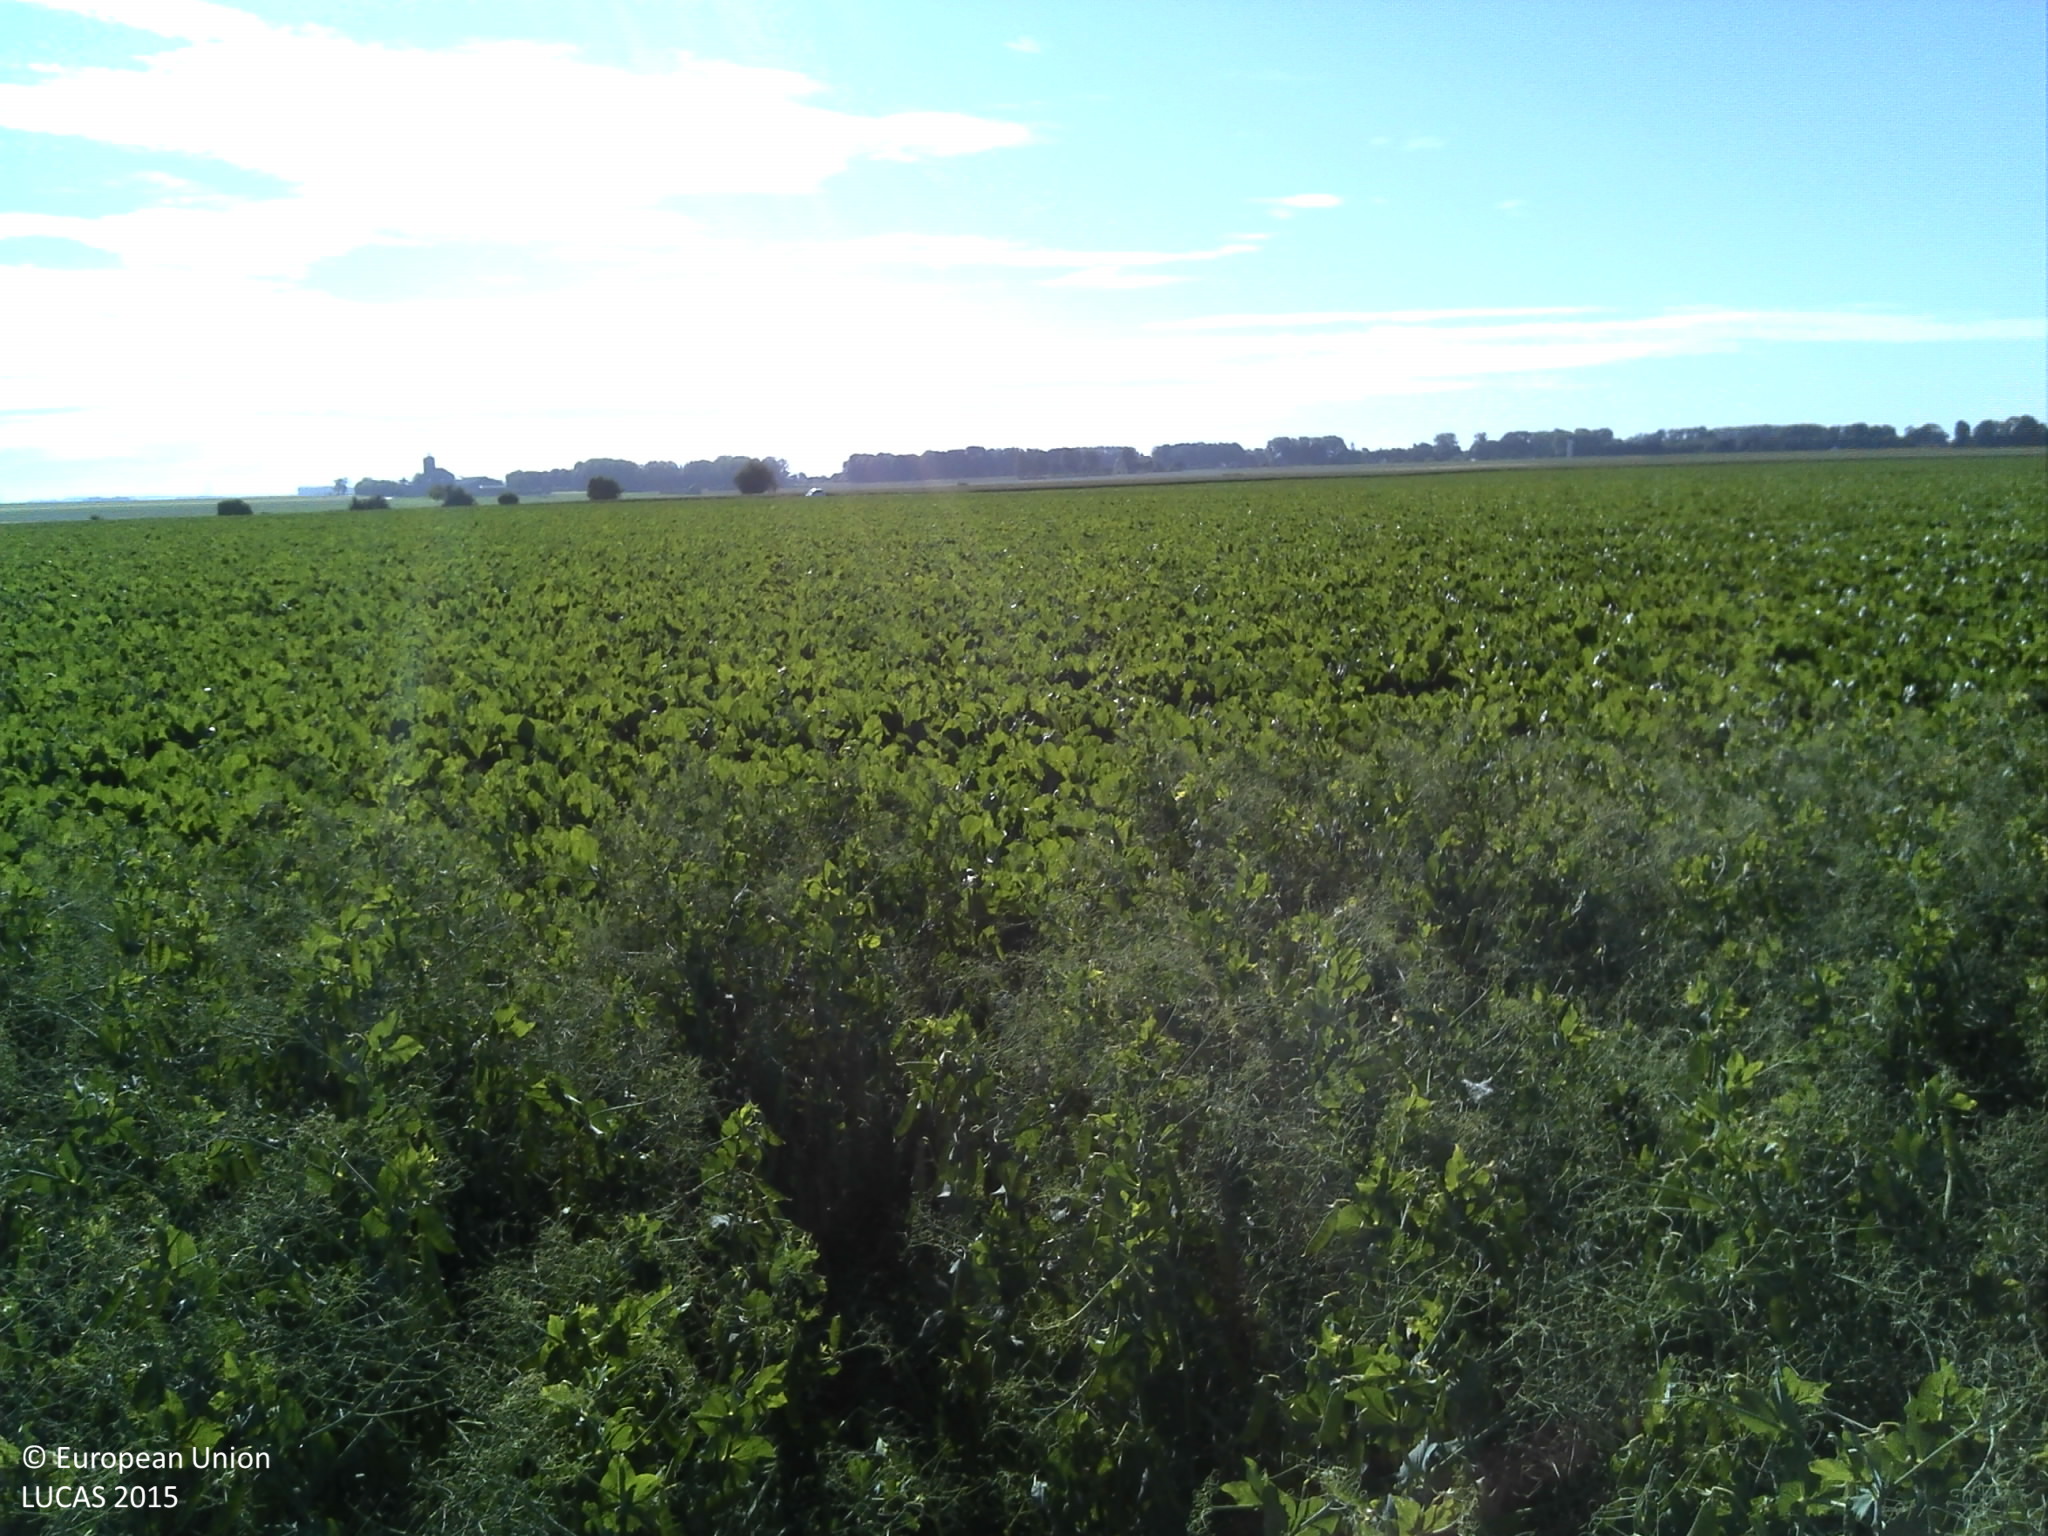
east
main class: Cropland
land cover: Dry pulses
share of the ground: > 75 %
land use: Agriculture (excluding fallow land and kitchen gardens)
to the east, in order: Dry pulses; Electric lines; Sugar beet; Grass margins; Paved roads, cycling and walking lanes; Grass margins; Common wheat
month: June
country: FR
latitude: 49.7751
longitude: 1.0209
